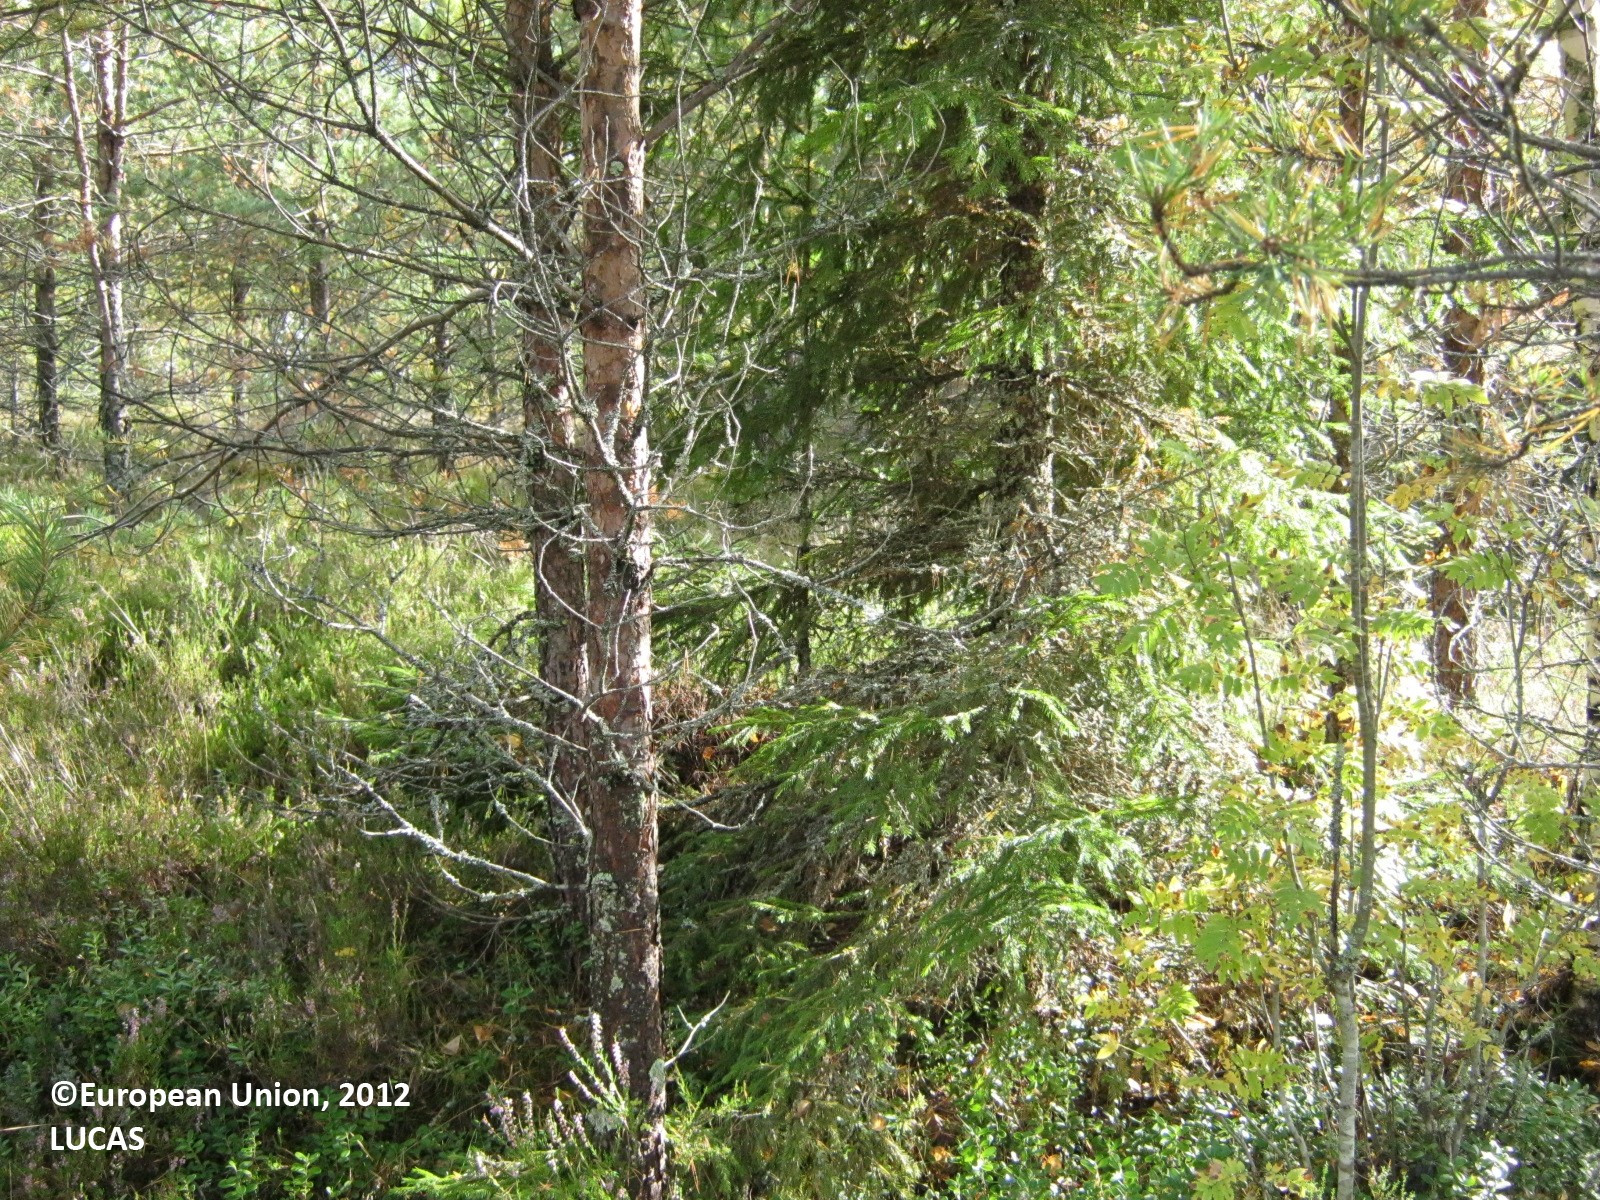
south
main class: Woodland
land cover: Pine dominated mixed woodland
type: boreal forest
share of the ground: > 75 %
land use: Forestry
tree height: > 5 m
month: September
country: FI
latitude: 60.6191
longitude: 27.8674
